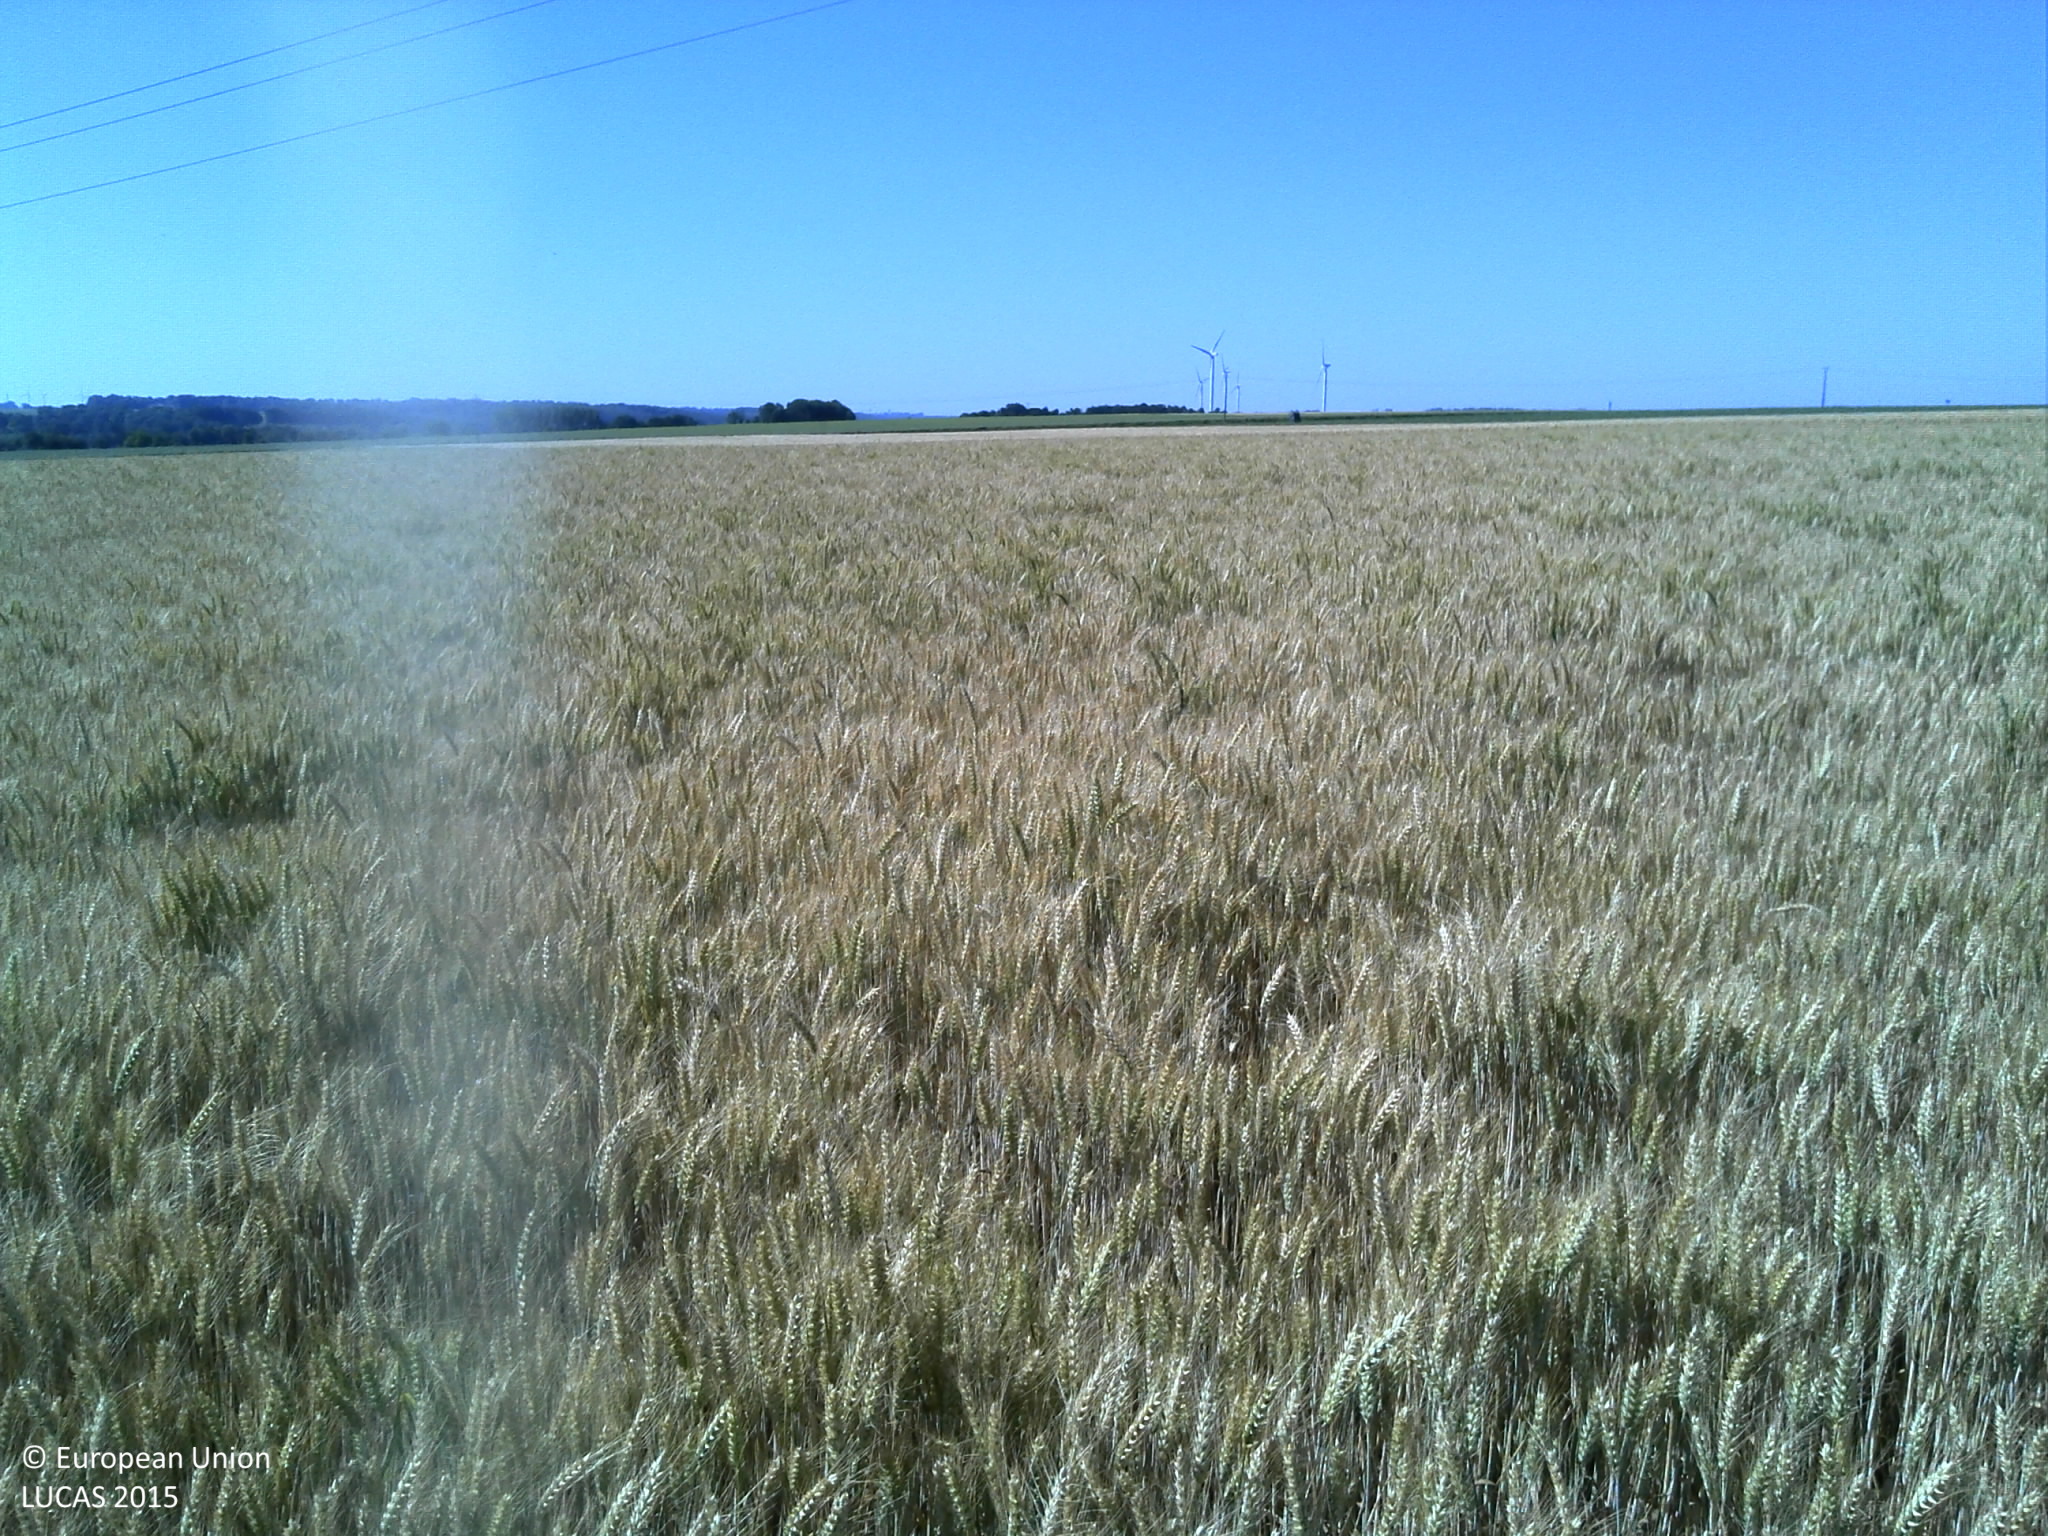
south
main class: Cropland
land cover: Durum wheat
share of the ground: > 75 %
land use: Agriculture (excluding fallow land and kitchen gardens)
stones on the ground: 10 - 25 %
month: June
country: FR
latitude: 49.8420
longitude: 0.9523
